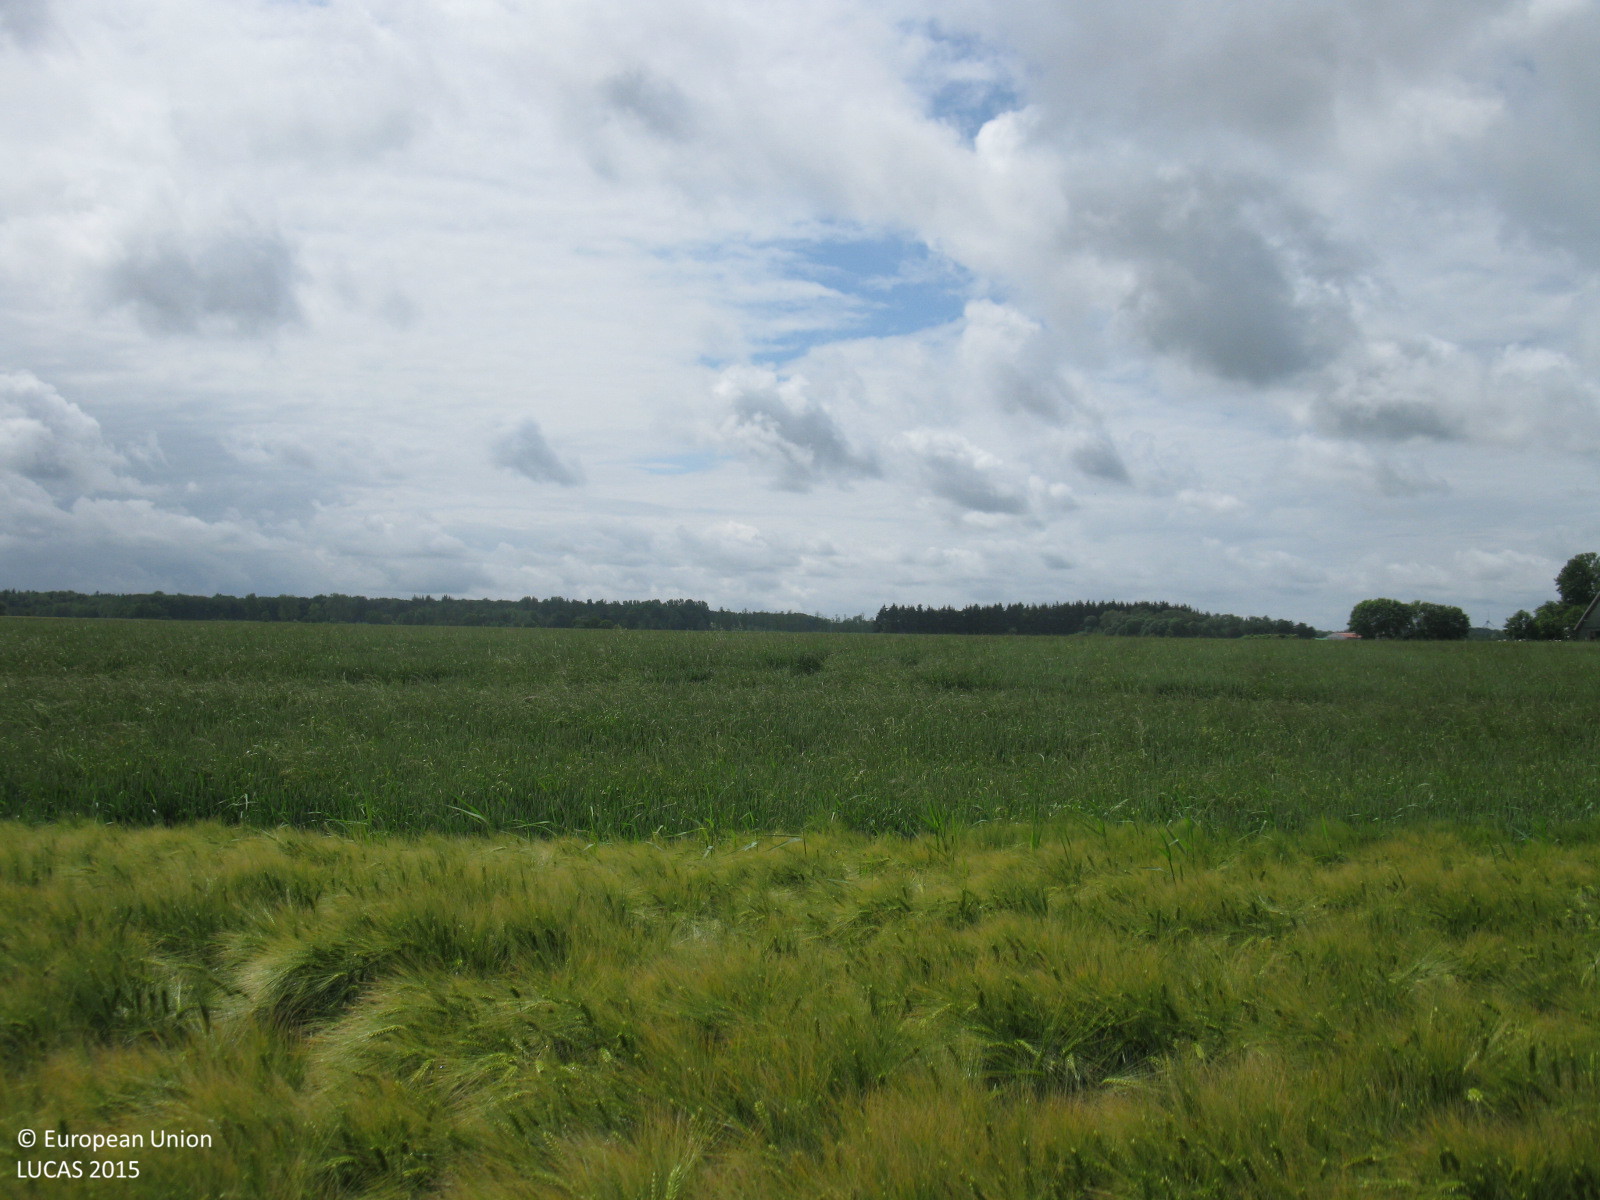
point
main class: Cropland
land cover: Common wheat
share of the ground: > 75 %
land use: Agriculture (excluding fallow land and kitchen gardens)
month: June
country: DE
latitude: 53.6242
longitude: 7.3245
